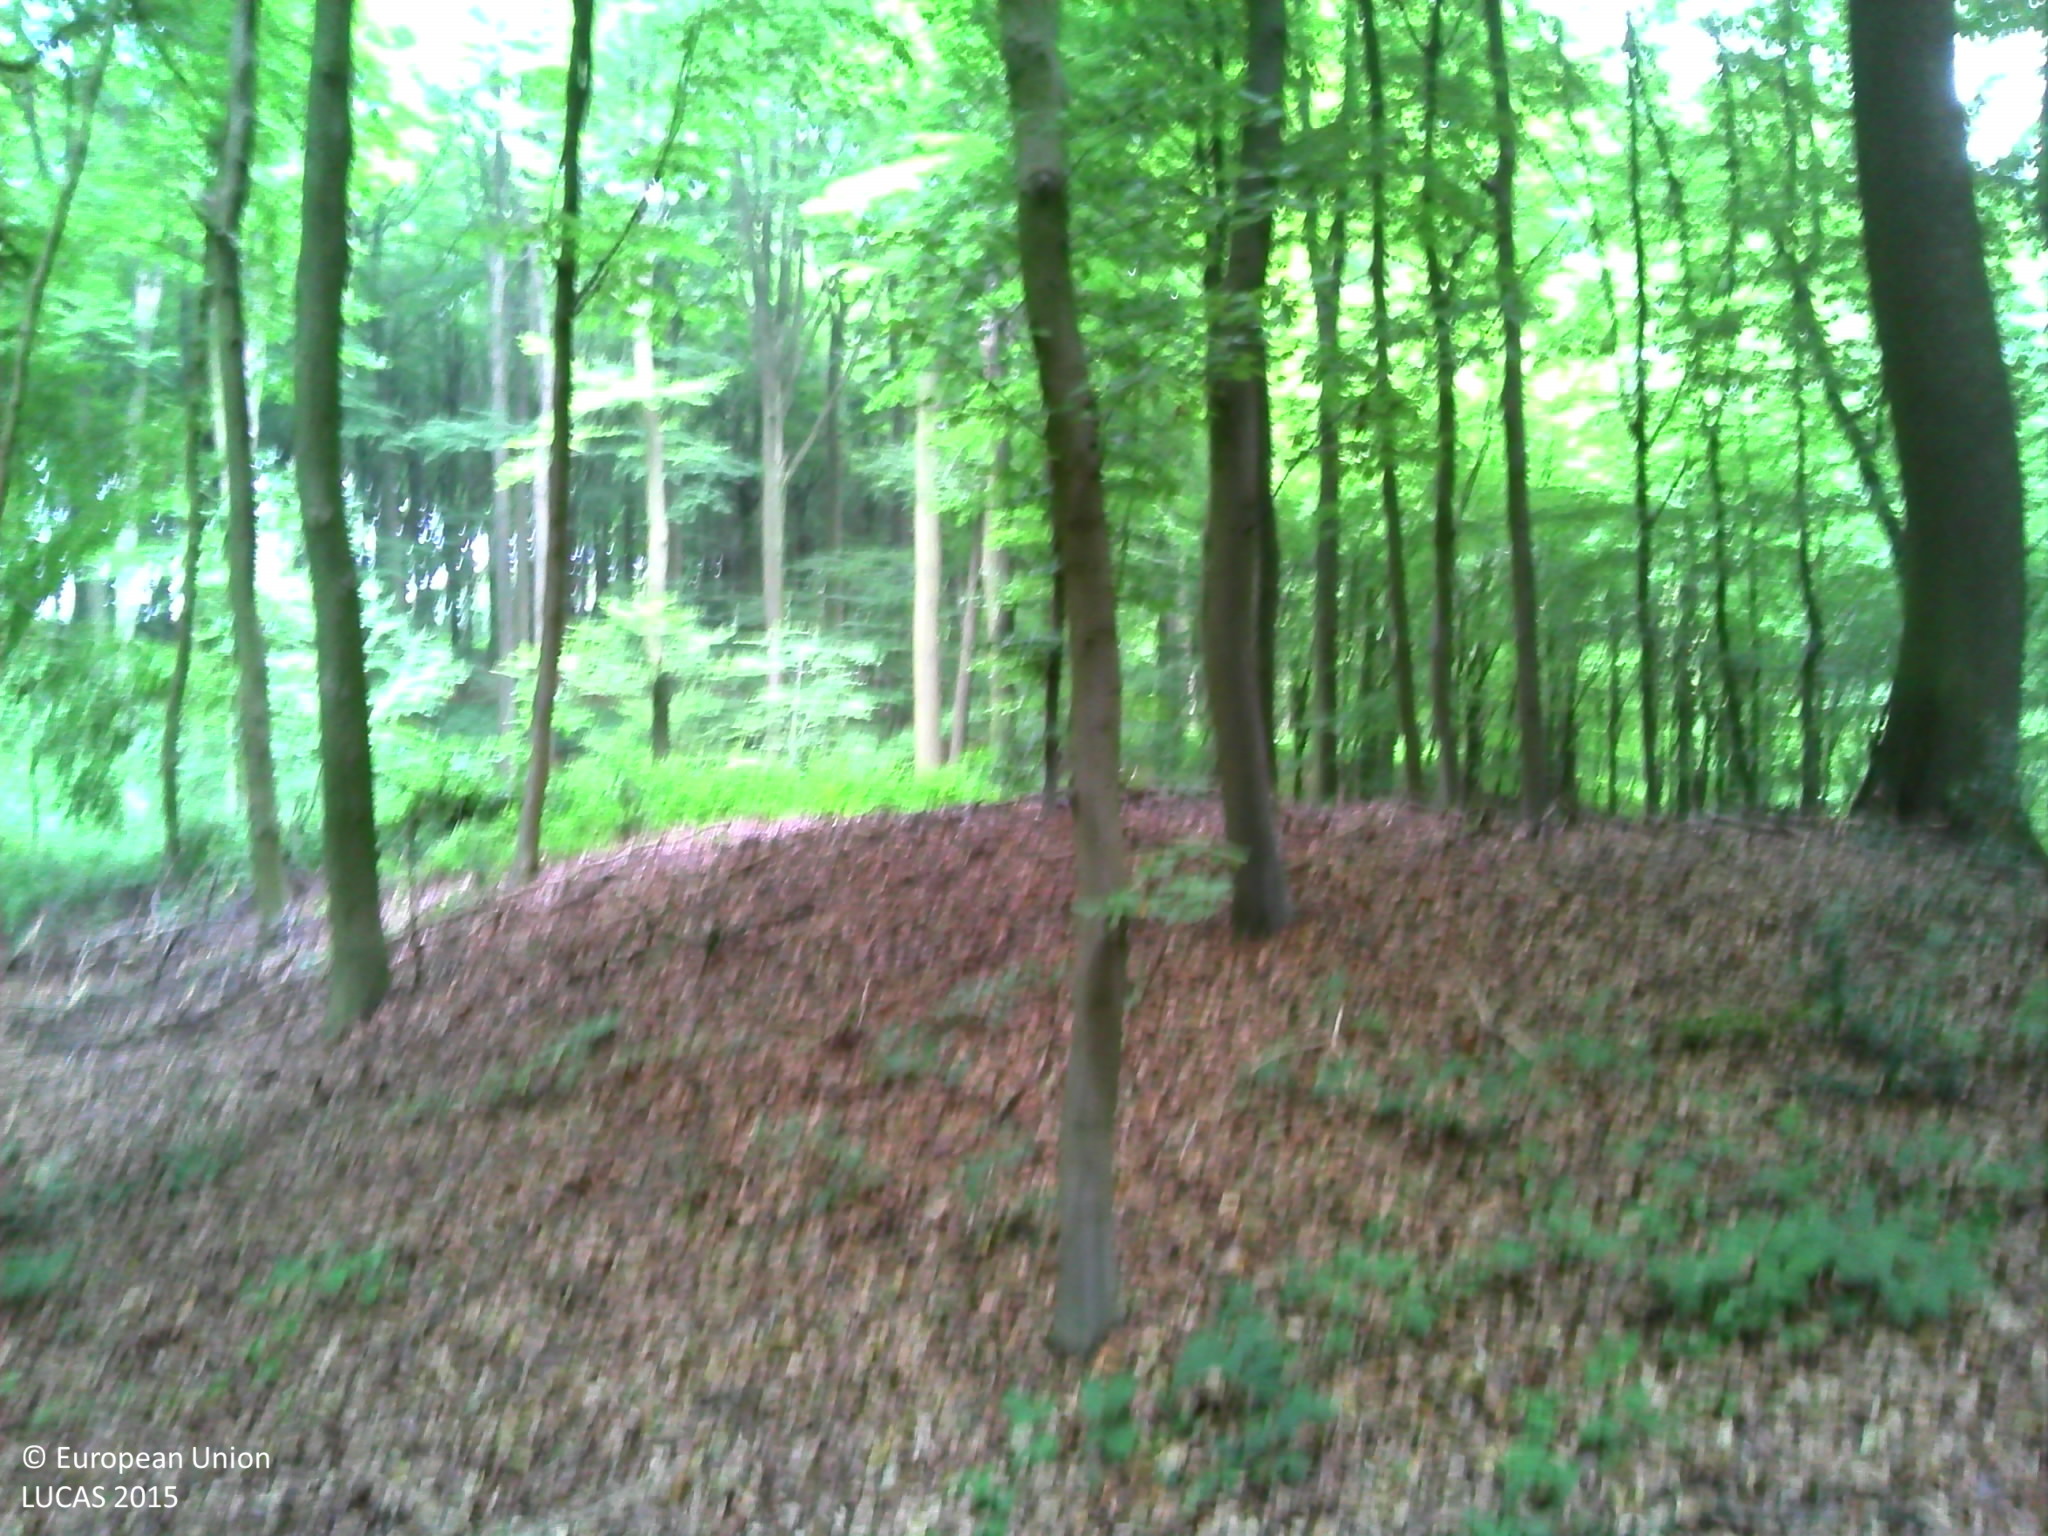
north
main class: Woodland
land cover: Broadleaved woodland
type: beech forest
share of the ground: > 75 %
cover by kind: broadleaved forest trees 90 %, shrubs 5 %, herbaceous plants 5 %
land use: Forestry
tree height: > 5 m
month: August
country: BE
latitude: 50.7098
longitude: 3.6343
